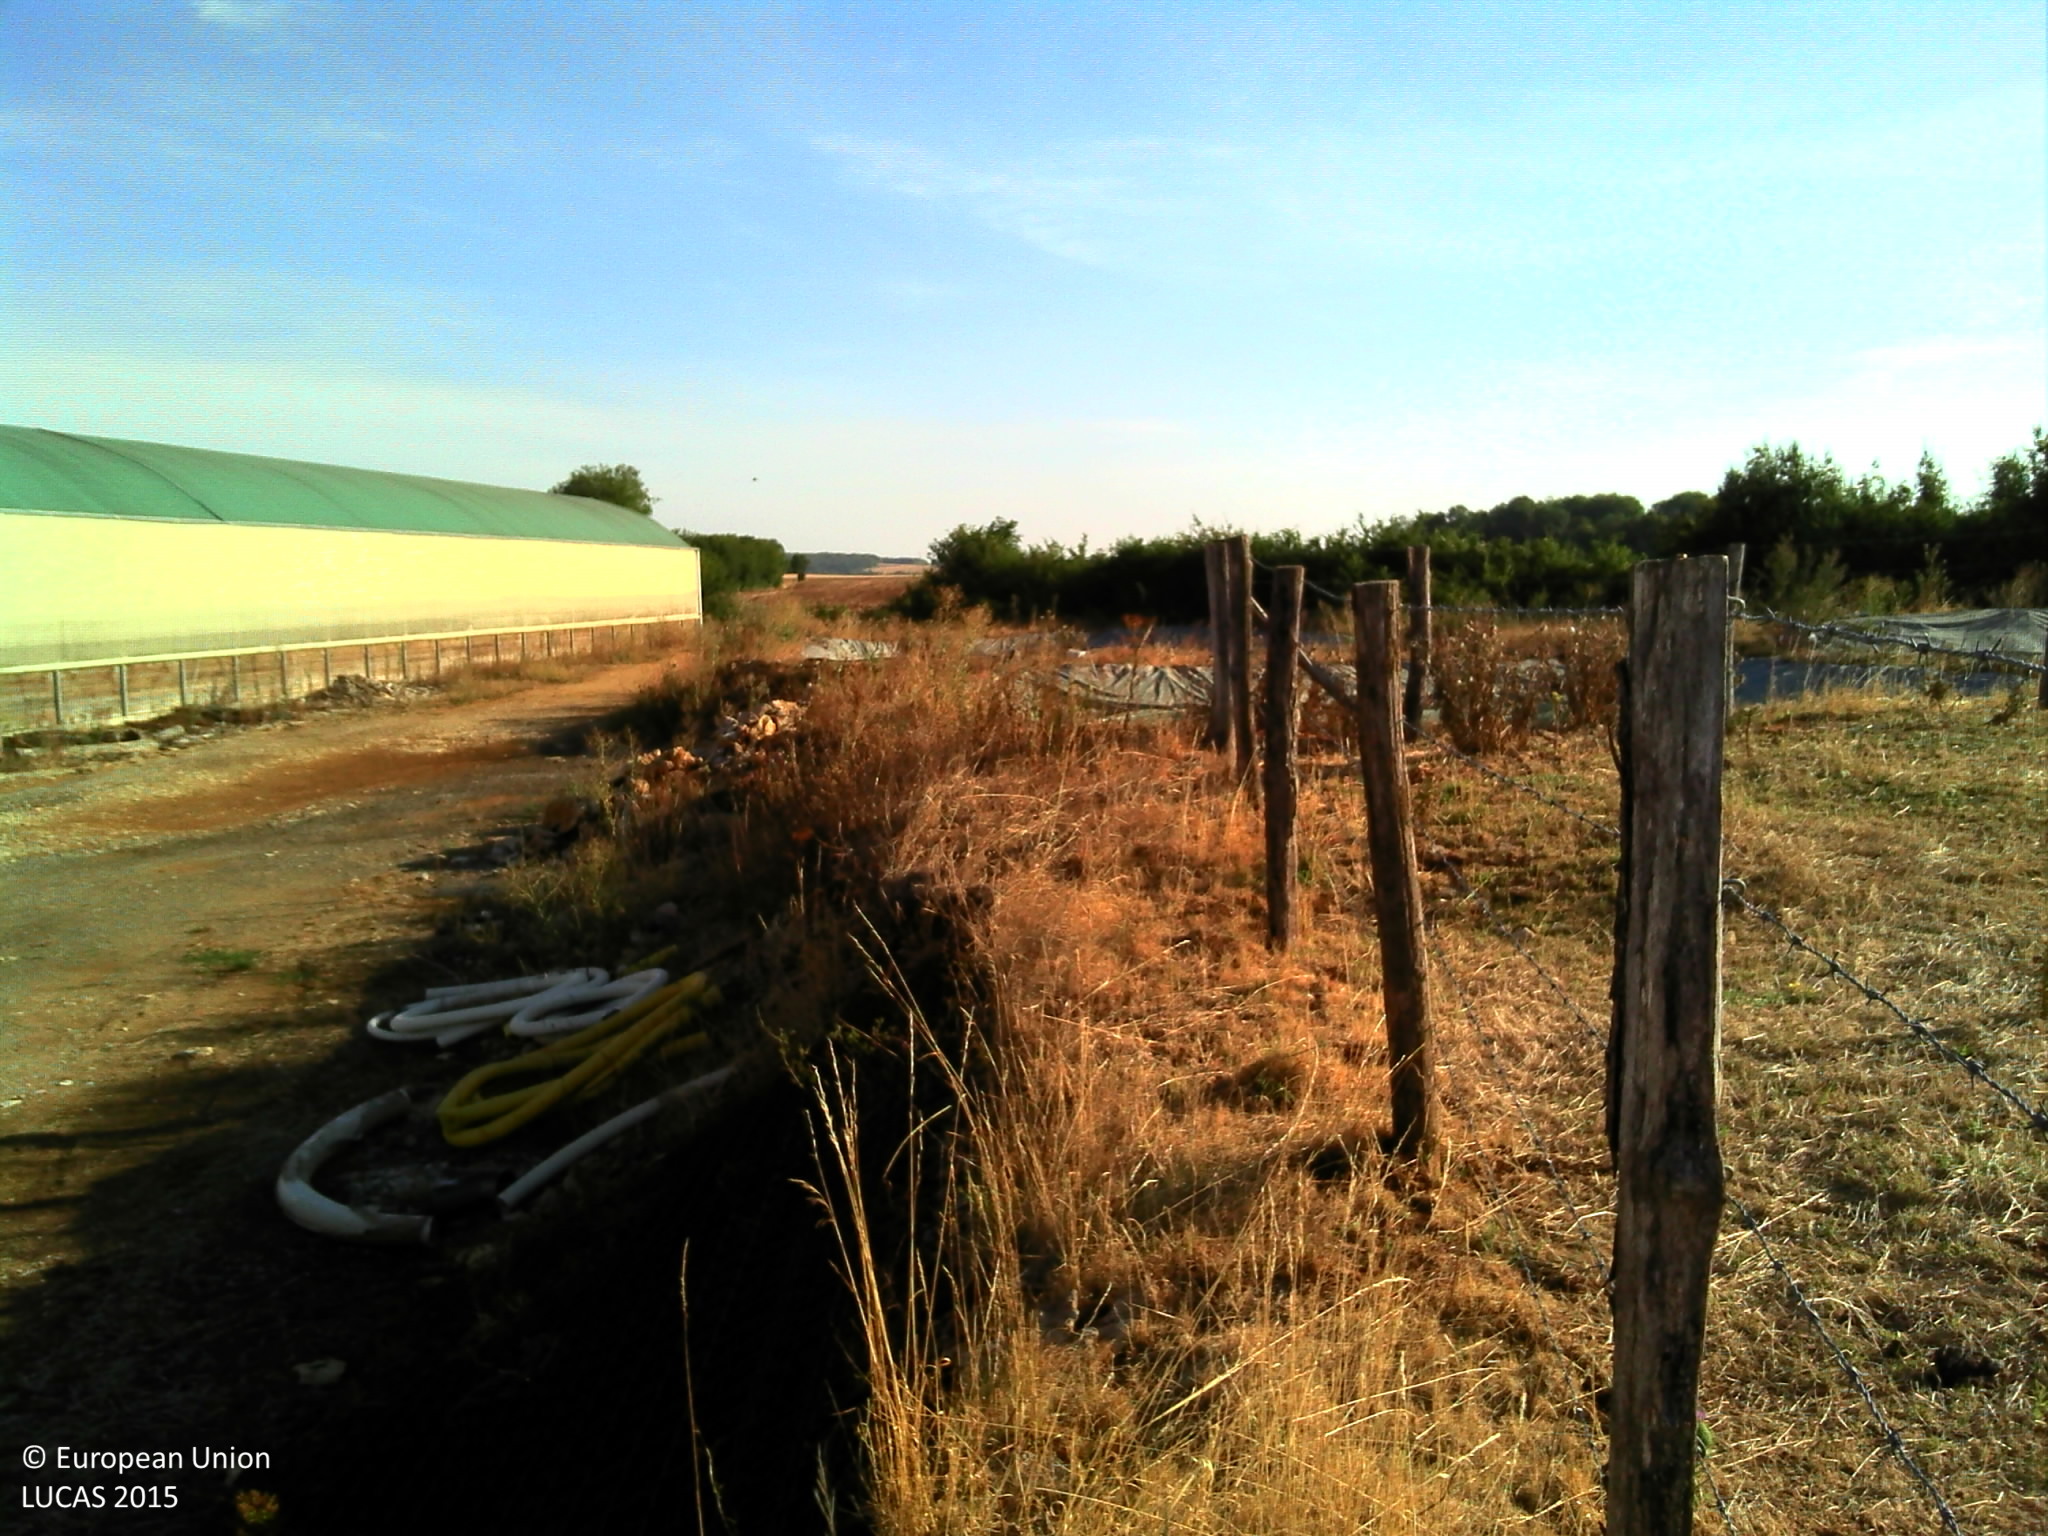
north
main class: Grassland
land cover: Grassland without tree/shrub cover
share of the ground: > 75 %
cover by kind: herbaceous plants 95 %, unconsolidated bare surface 5 %
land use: Agriculture (excluding fallow land and kitchen gardens)
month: July
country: FR
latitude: 47.6836
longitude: 5.1376
